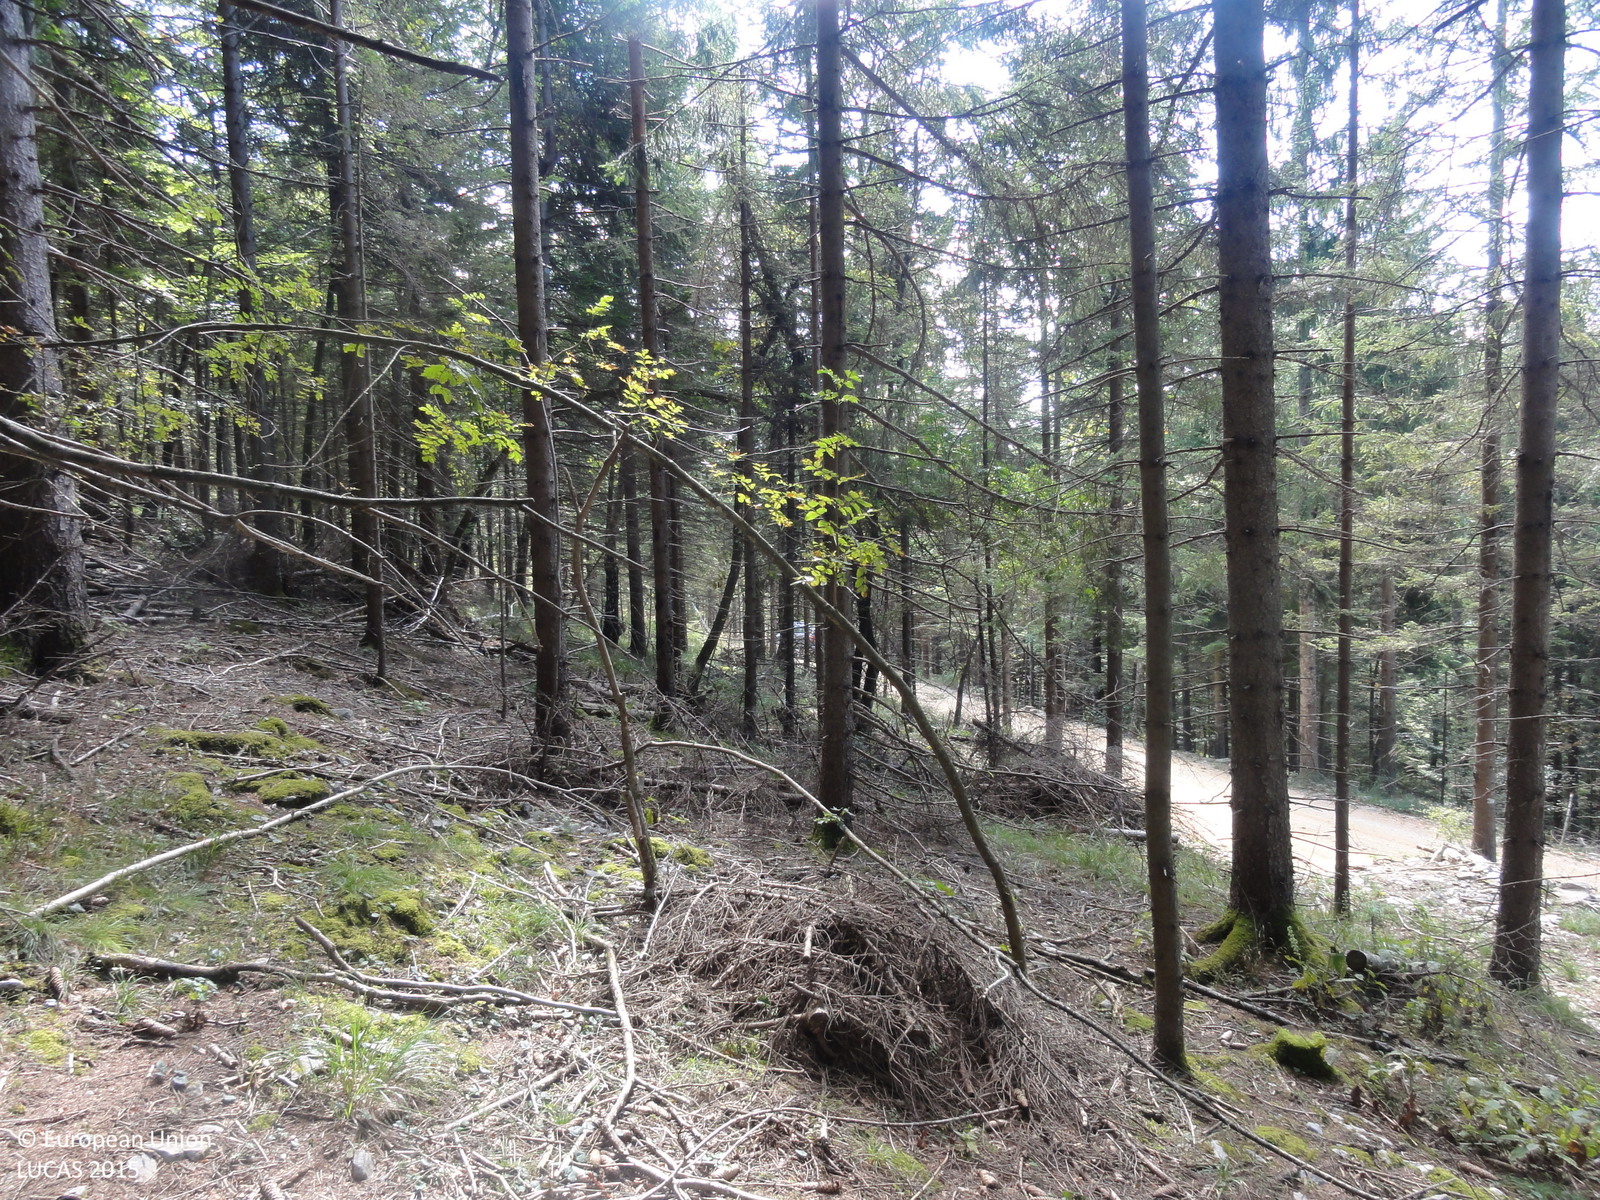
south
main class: Woodland
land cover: Spruce dominated coniferous woodland
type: hemiboreal forest and nemoral coniferous forest and mixed broadleaved-coniferous forest
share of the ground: > 75 %
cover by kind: coniferous forest trees 85 %, unconsolidated bare surface 10 %, broadleaved forest trees 5 %
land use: Forestry
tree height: > 5 m
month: September
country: SI
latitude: 45.7280
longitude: 15.0204
